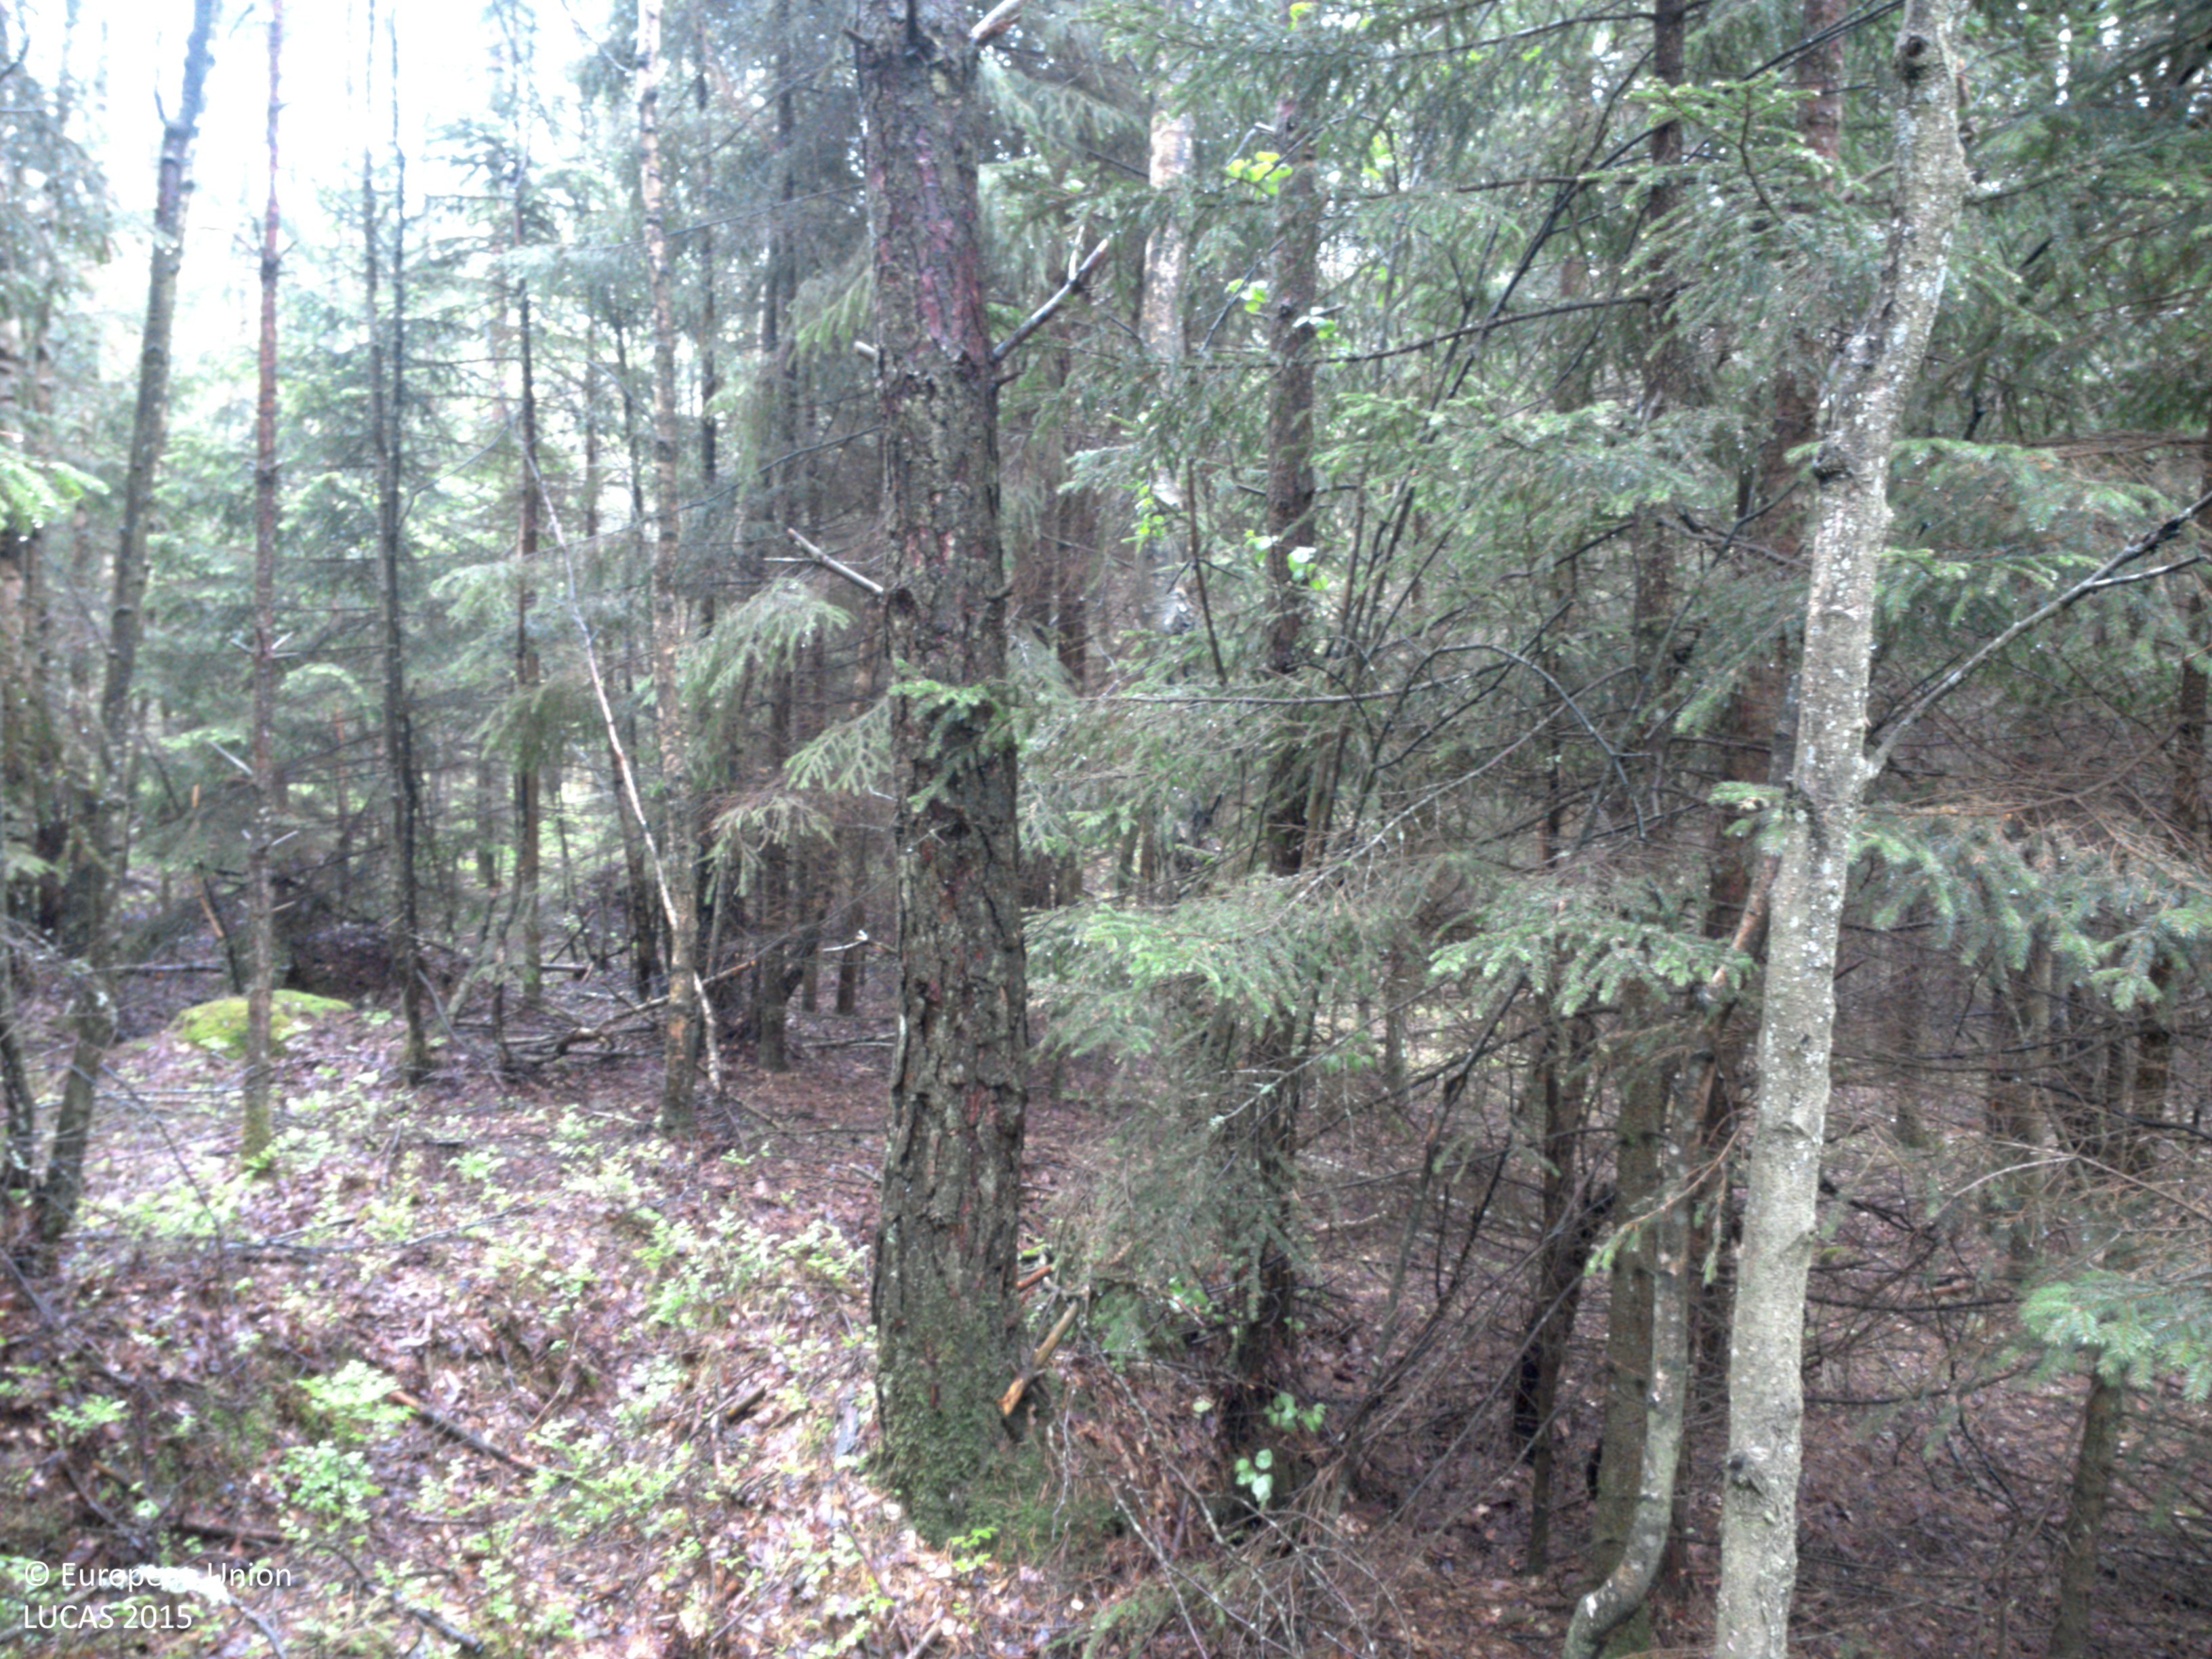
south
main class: Woodland
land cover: Pine dominated mixed woodland
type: boreal forest
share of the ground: 50 - 75 %
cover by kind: coniferous forest trees 45 %, herbaceous plants 30 %, broadleaved forest trees 25 %
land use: Forestry
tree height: > 5 m
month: June
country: SE
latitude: 57.8045
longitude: 12.2679
